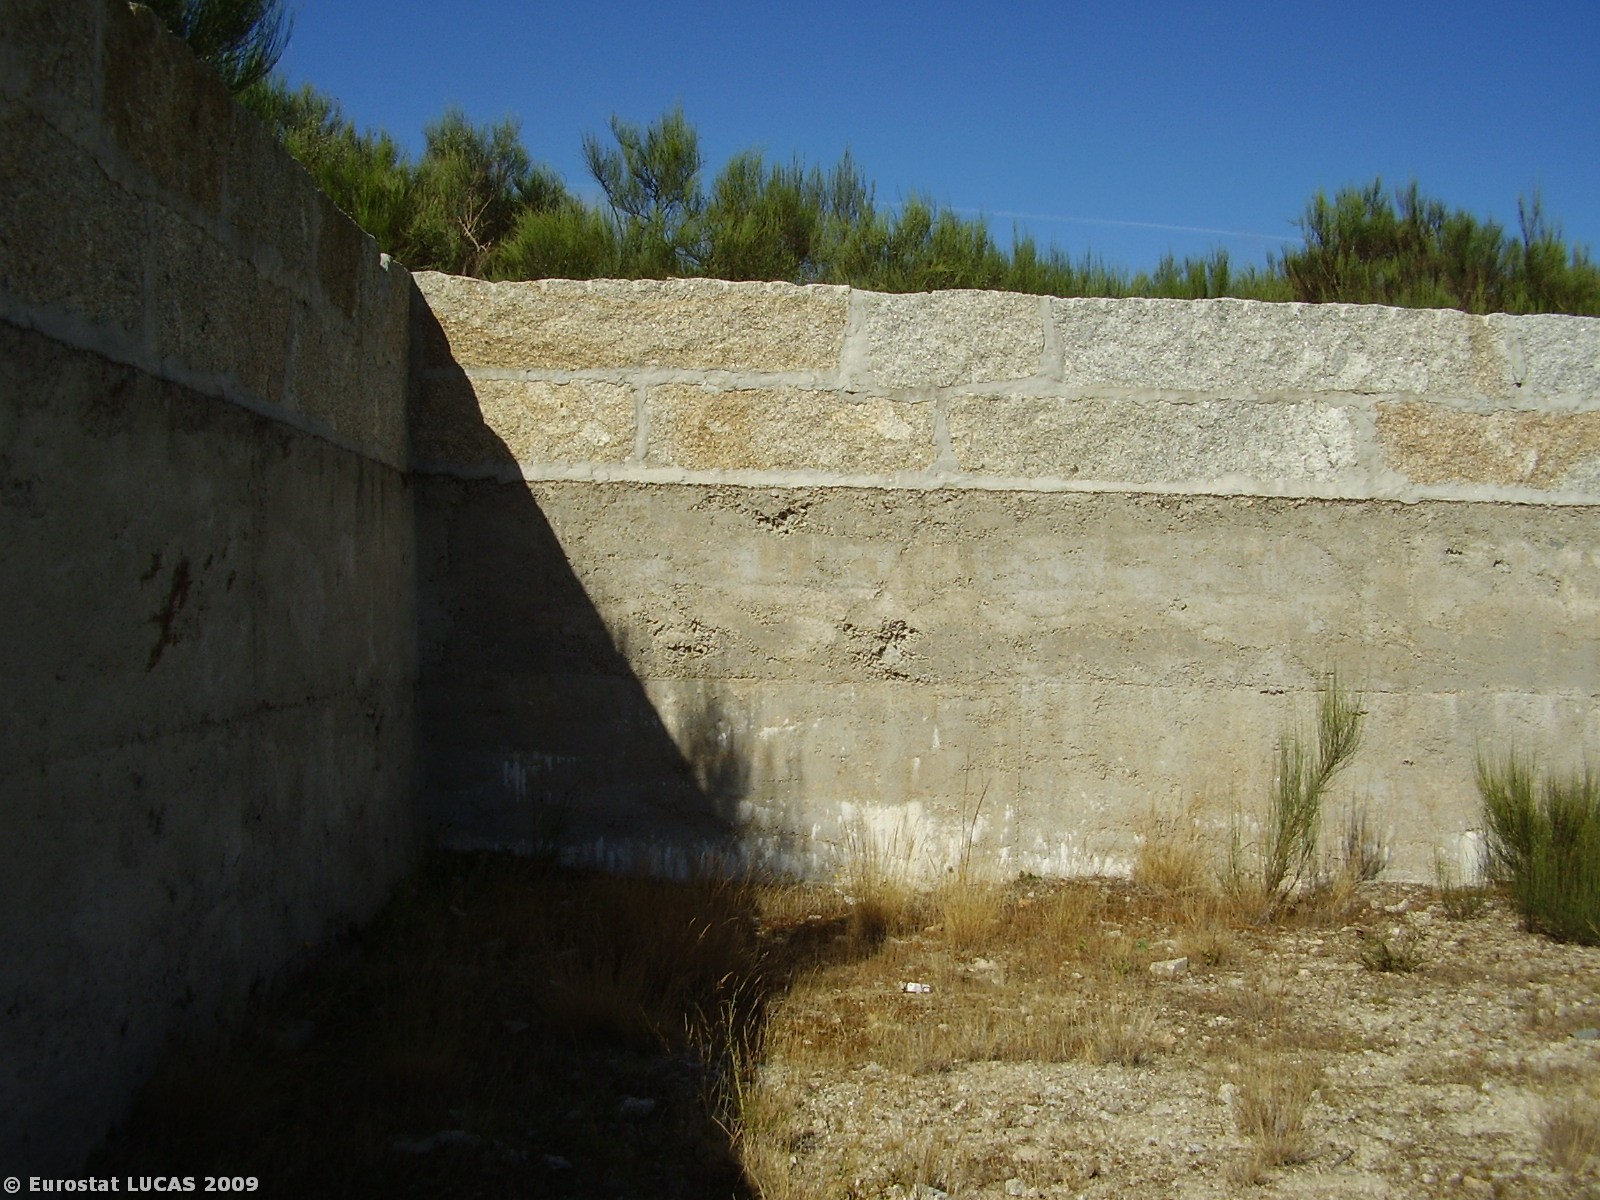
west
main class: Grassland
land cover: Spontaneously vegetated surfaces
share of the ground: 50 - 75 %
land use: Fallow land
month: September
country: PT
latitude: 41.7135
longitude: -7.7697
